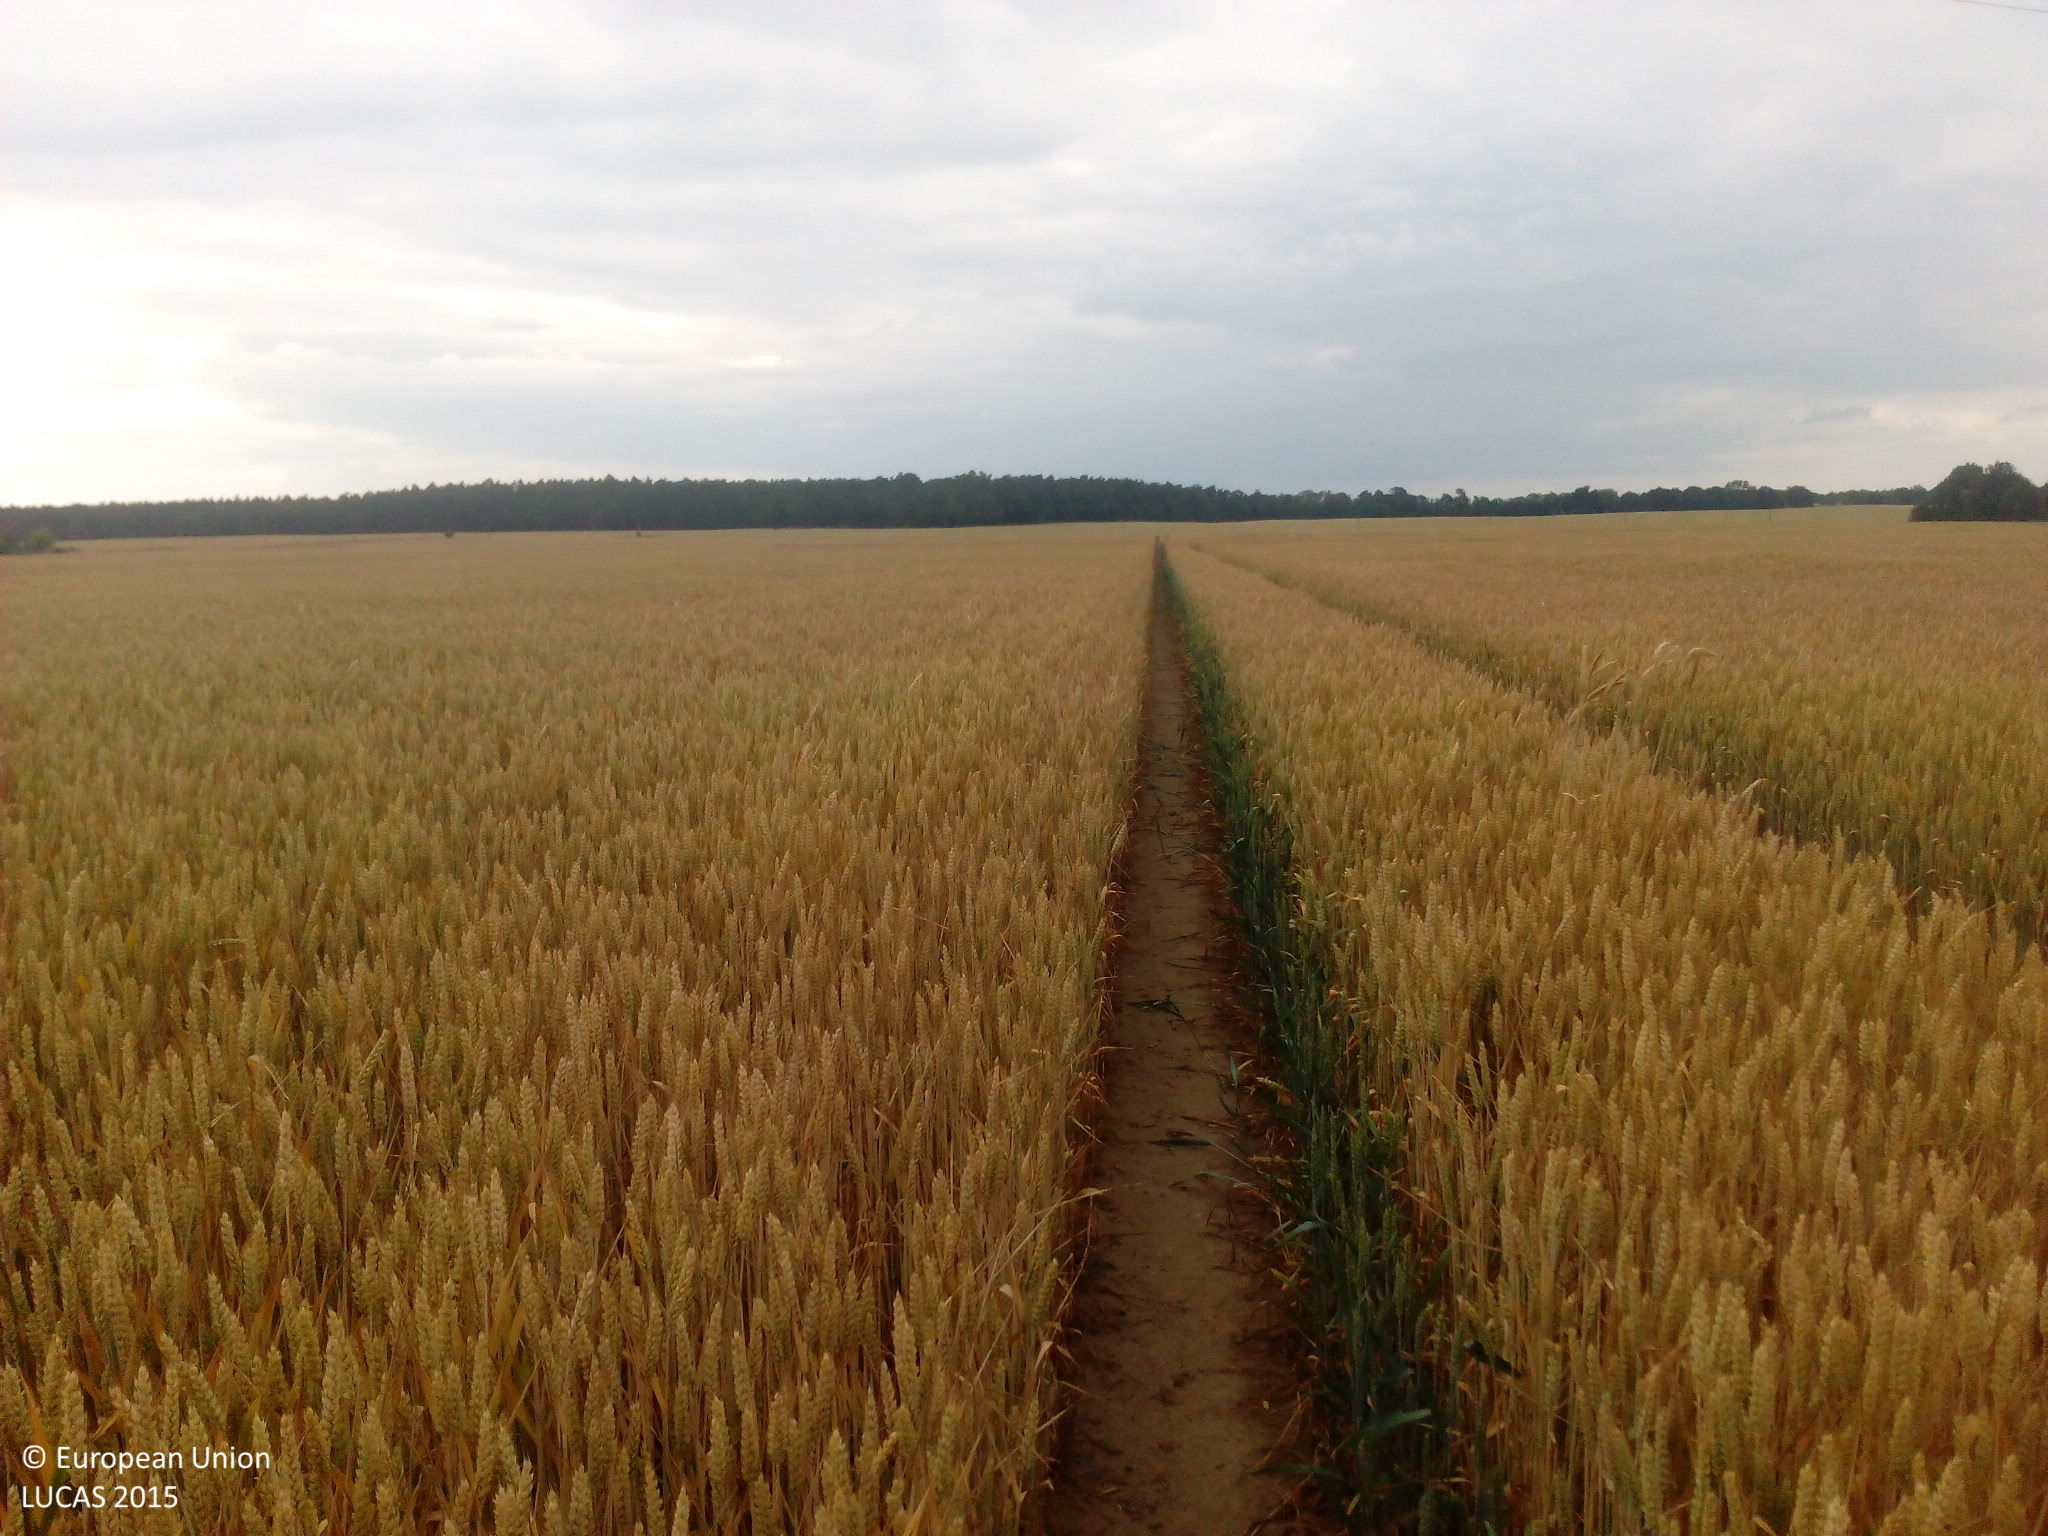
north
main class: Cropland
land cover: Common wheat
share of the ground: > 75 %
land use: Agriculture (excluding fallow land and kitchen gardens)
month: July
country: DE
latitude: 52.9120
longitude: 12.3341
